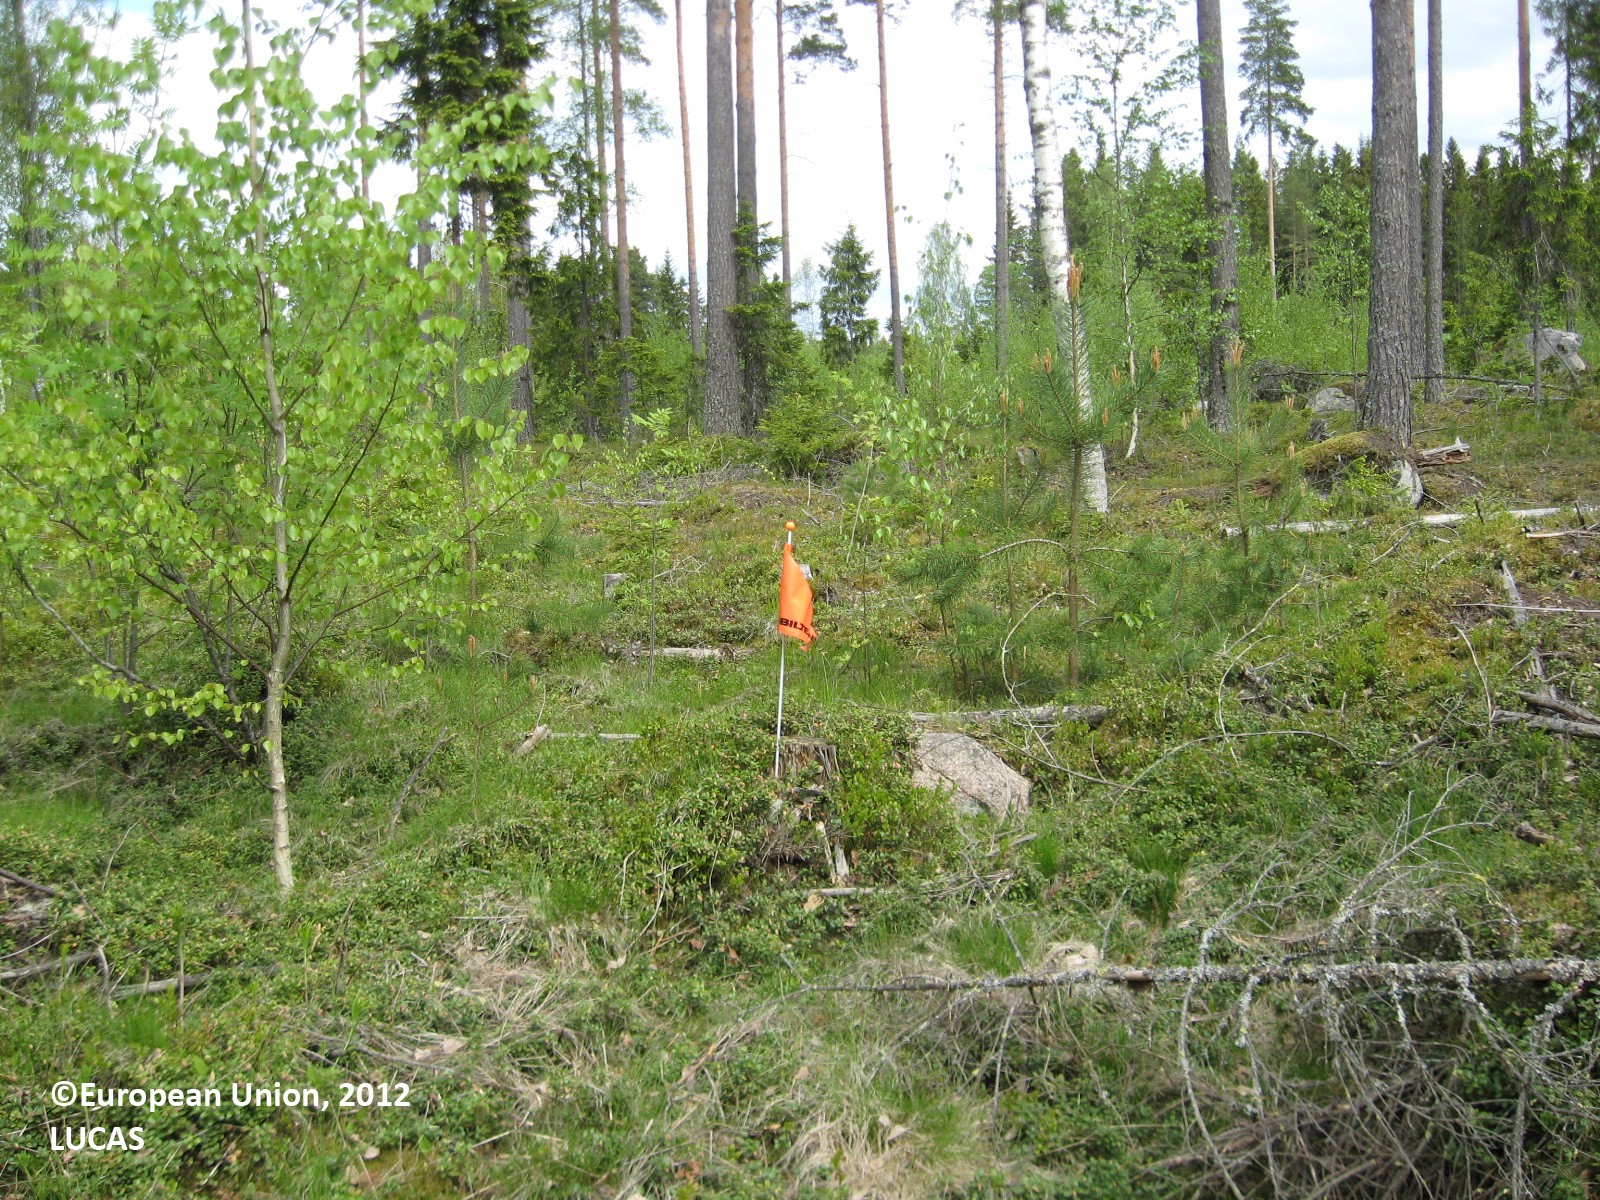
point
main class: Woodland
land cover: Other mixed woodland
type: boreal forest
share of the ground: 25 - 50 %
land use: Forestry
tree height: < 5 m
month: May
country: FI
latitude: 61.8411
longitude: 22.6183
